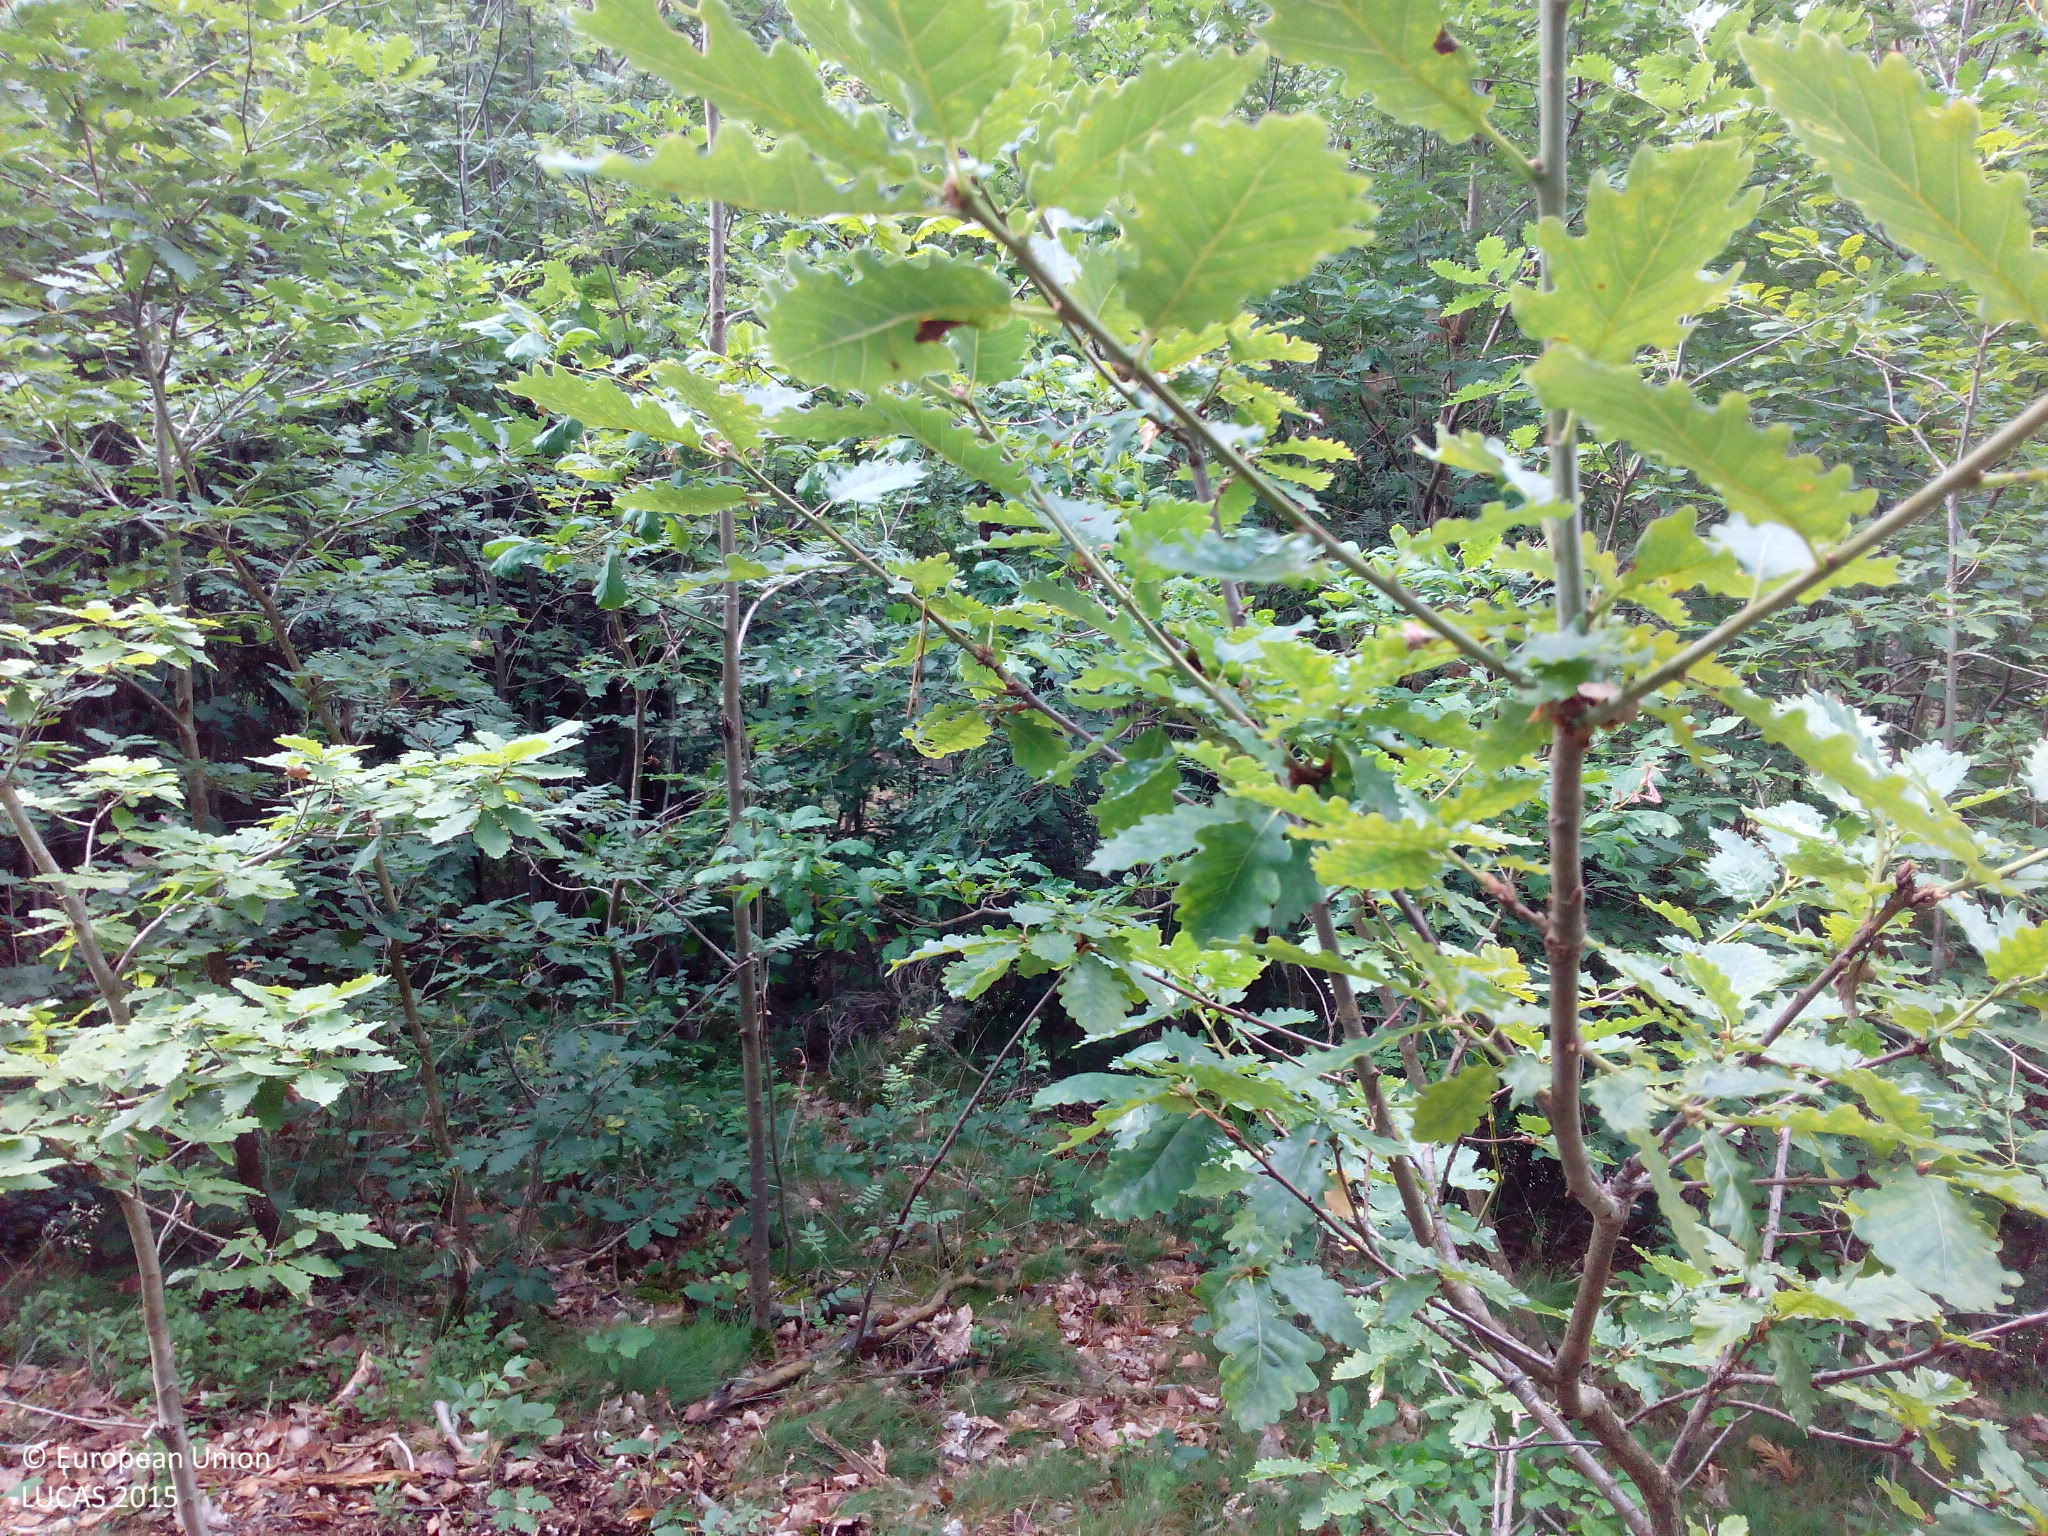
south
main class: Woodland
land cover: Pine dominated mixed woodland
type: hemiboreal forest and nemoral coniferous forest and mixed broadleaved-coniferous forest
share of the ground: > 75 %
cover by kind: broadleaved forest trees 45 %, coniferous forest trees 40 %, herbaceous plants 5 %, lichens and mosses 5 %, unconsolidated bare surface 5 %
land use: Forestry
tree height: > 5 m
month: June
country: DE
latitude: 49.1196
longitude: 10.8902
